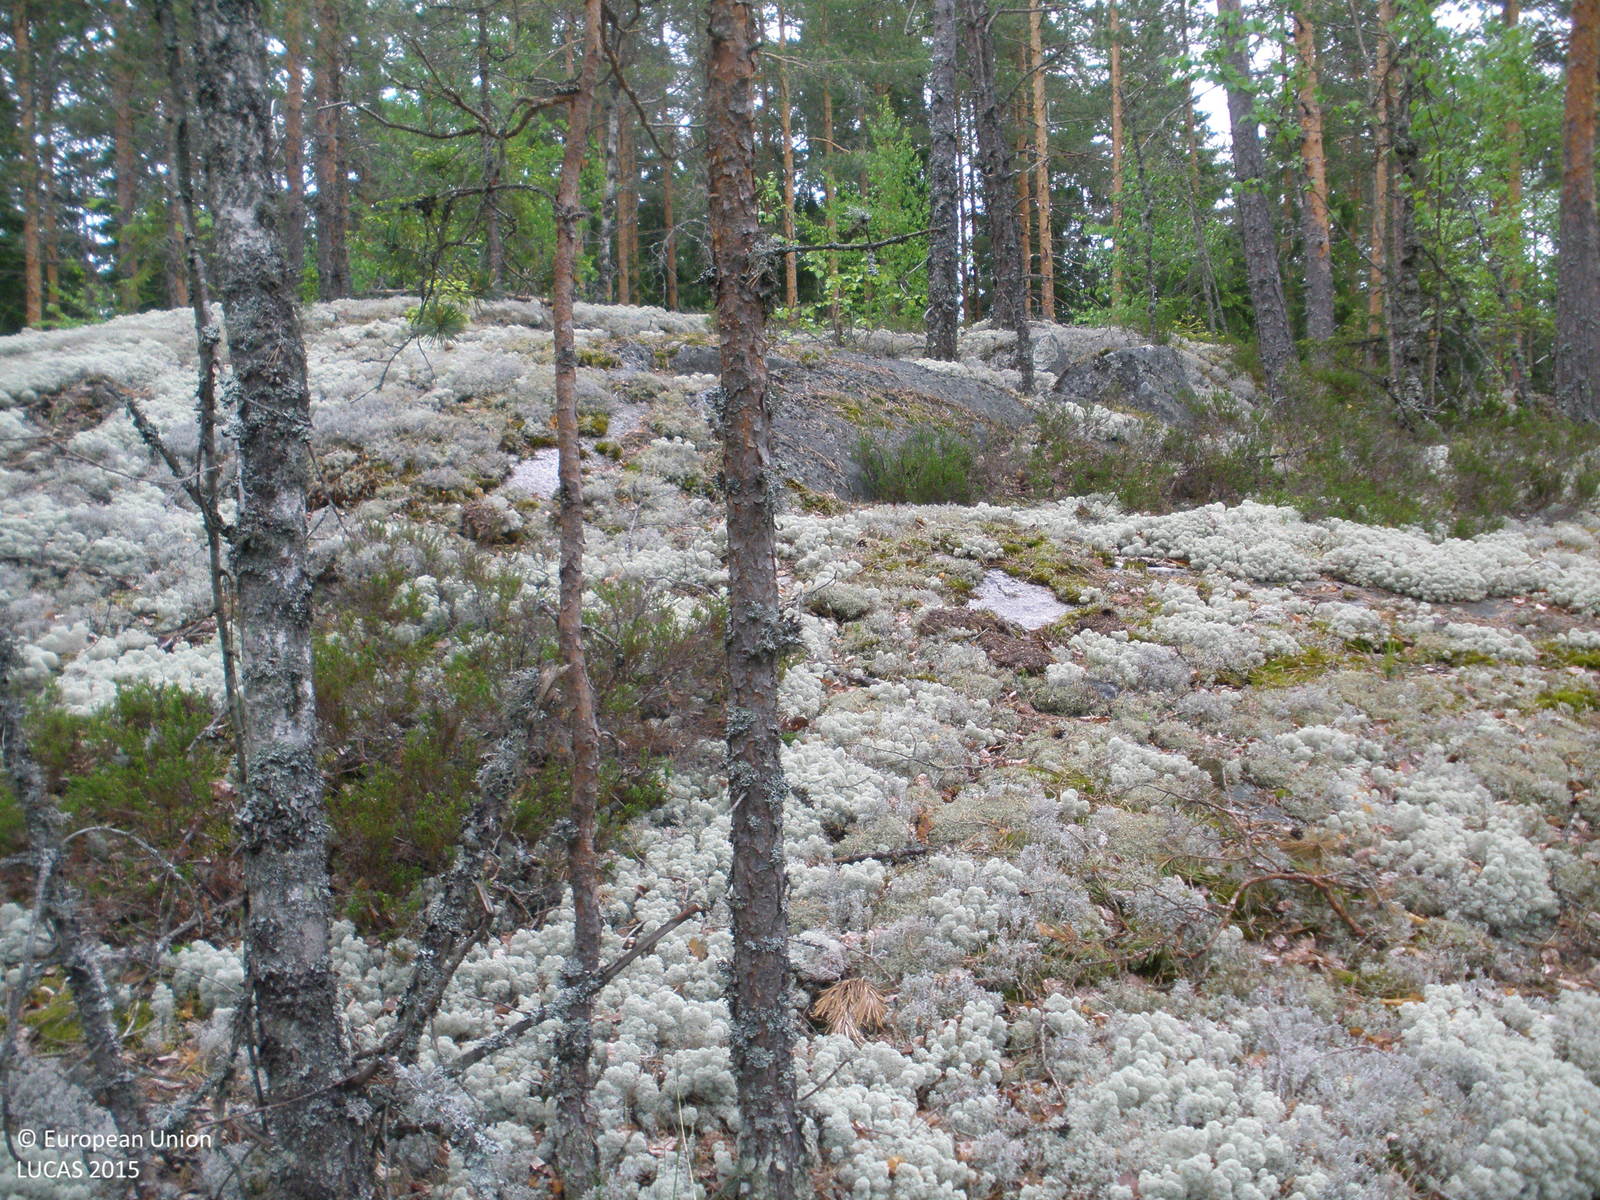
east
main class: Woodland
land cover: Pine dominated coniferous woodland
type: boreal forest
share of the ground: 50 - 75 %
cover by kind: coniferous forest trees 60 %, lichens and mosses 20 %, consolidated bare surface 10 %, broadleaved forest trees 5 %, shrubs 5 %
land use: Forestry
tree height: > 5 m
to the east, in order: Pine dominated coniferous woodland; Spruce dominated coniferous woodland; Tracks; Spruce dominated coniferous woodland; Spruce dominated mixed woodland
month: June
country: FI
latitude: 60.5556
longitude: 23.0818
